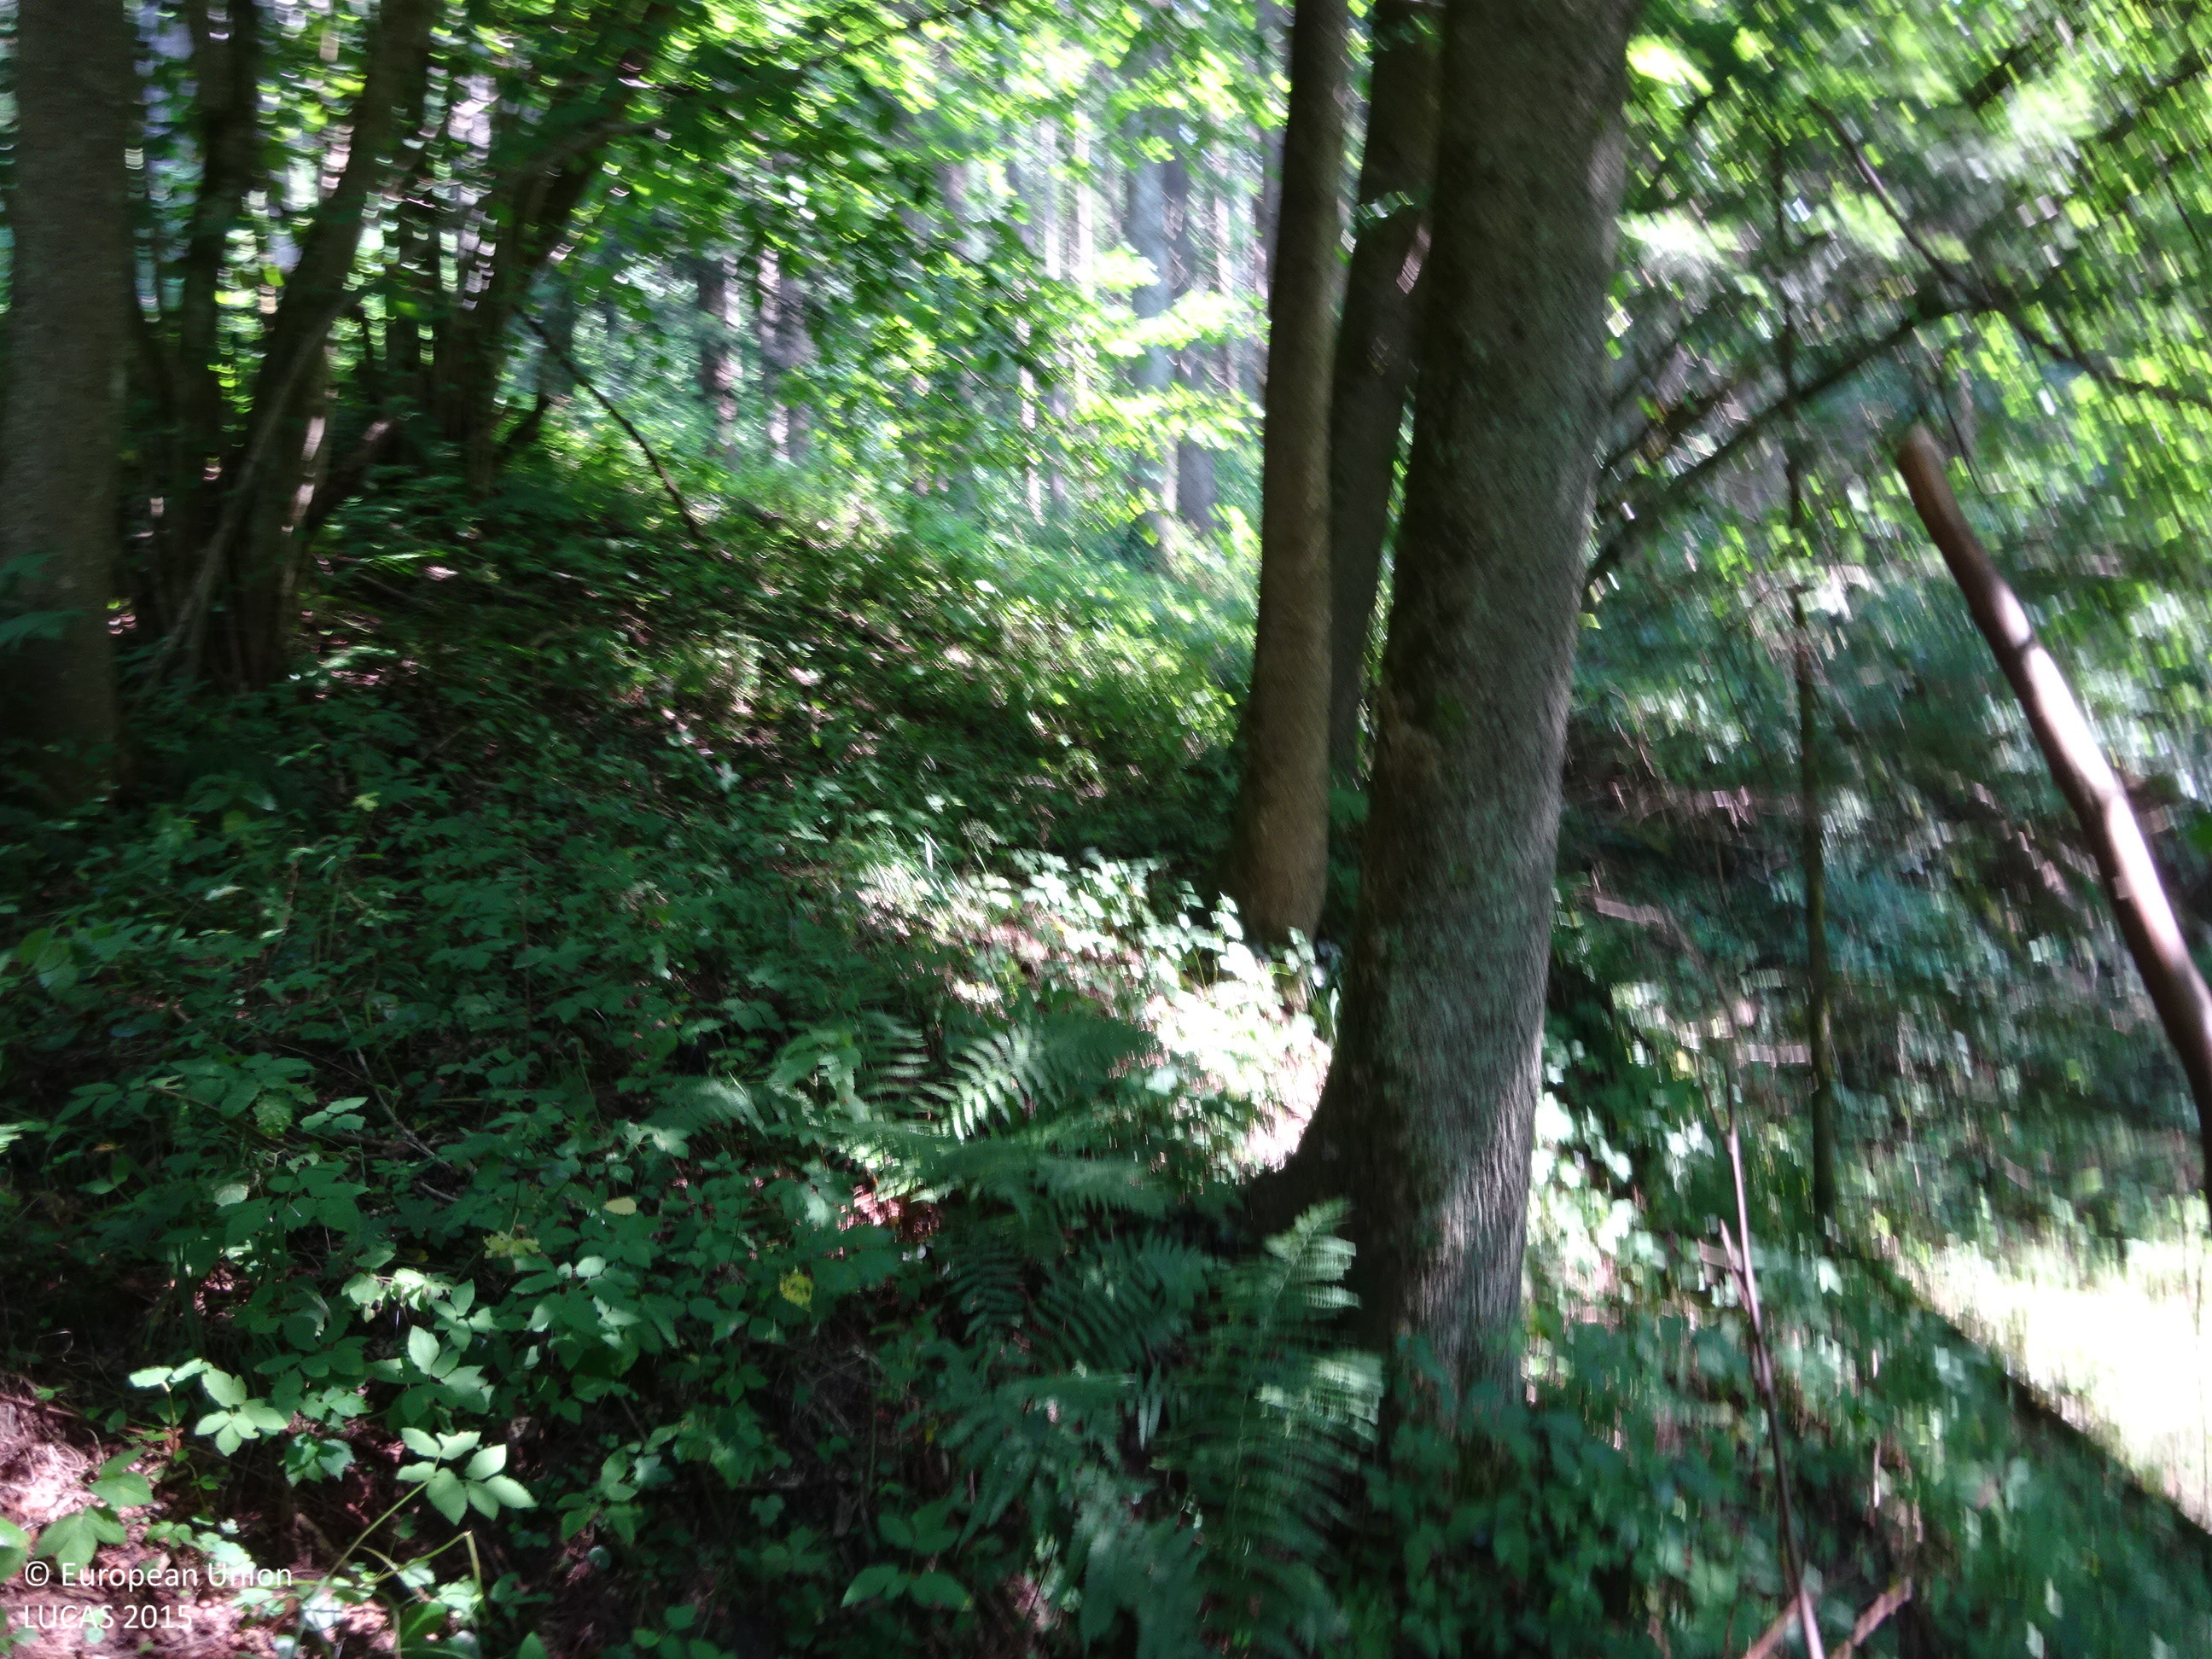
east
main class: Woodland
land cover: Spruce dominated mixed woodland
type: mountainous beech forest
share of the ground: > 75 %
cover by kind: broadleaved forest trees 45 %, coniferous forest trees 25 %, shrubs 20 %, unconsolidated bare surface 10 %
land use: Forestry
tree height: > 5 m
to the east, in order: Spruce dominated mixed woodland; Spruce dominated coniferous woodland; Broadleaved woodland; Spruce dominated mixed woodland; Shrubland without tree cover; Tracks; Spruce dominated mixed woodland
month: August
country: AT
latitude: 47.4280
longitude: 15.3165
